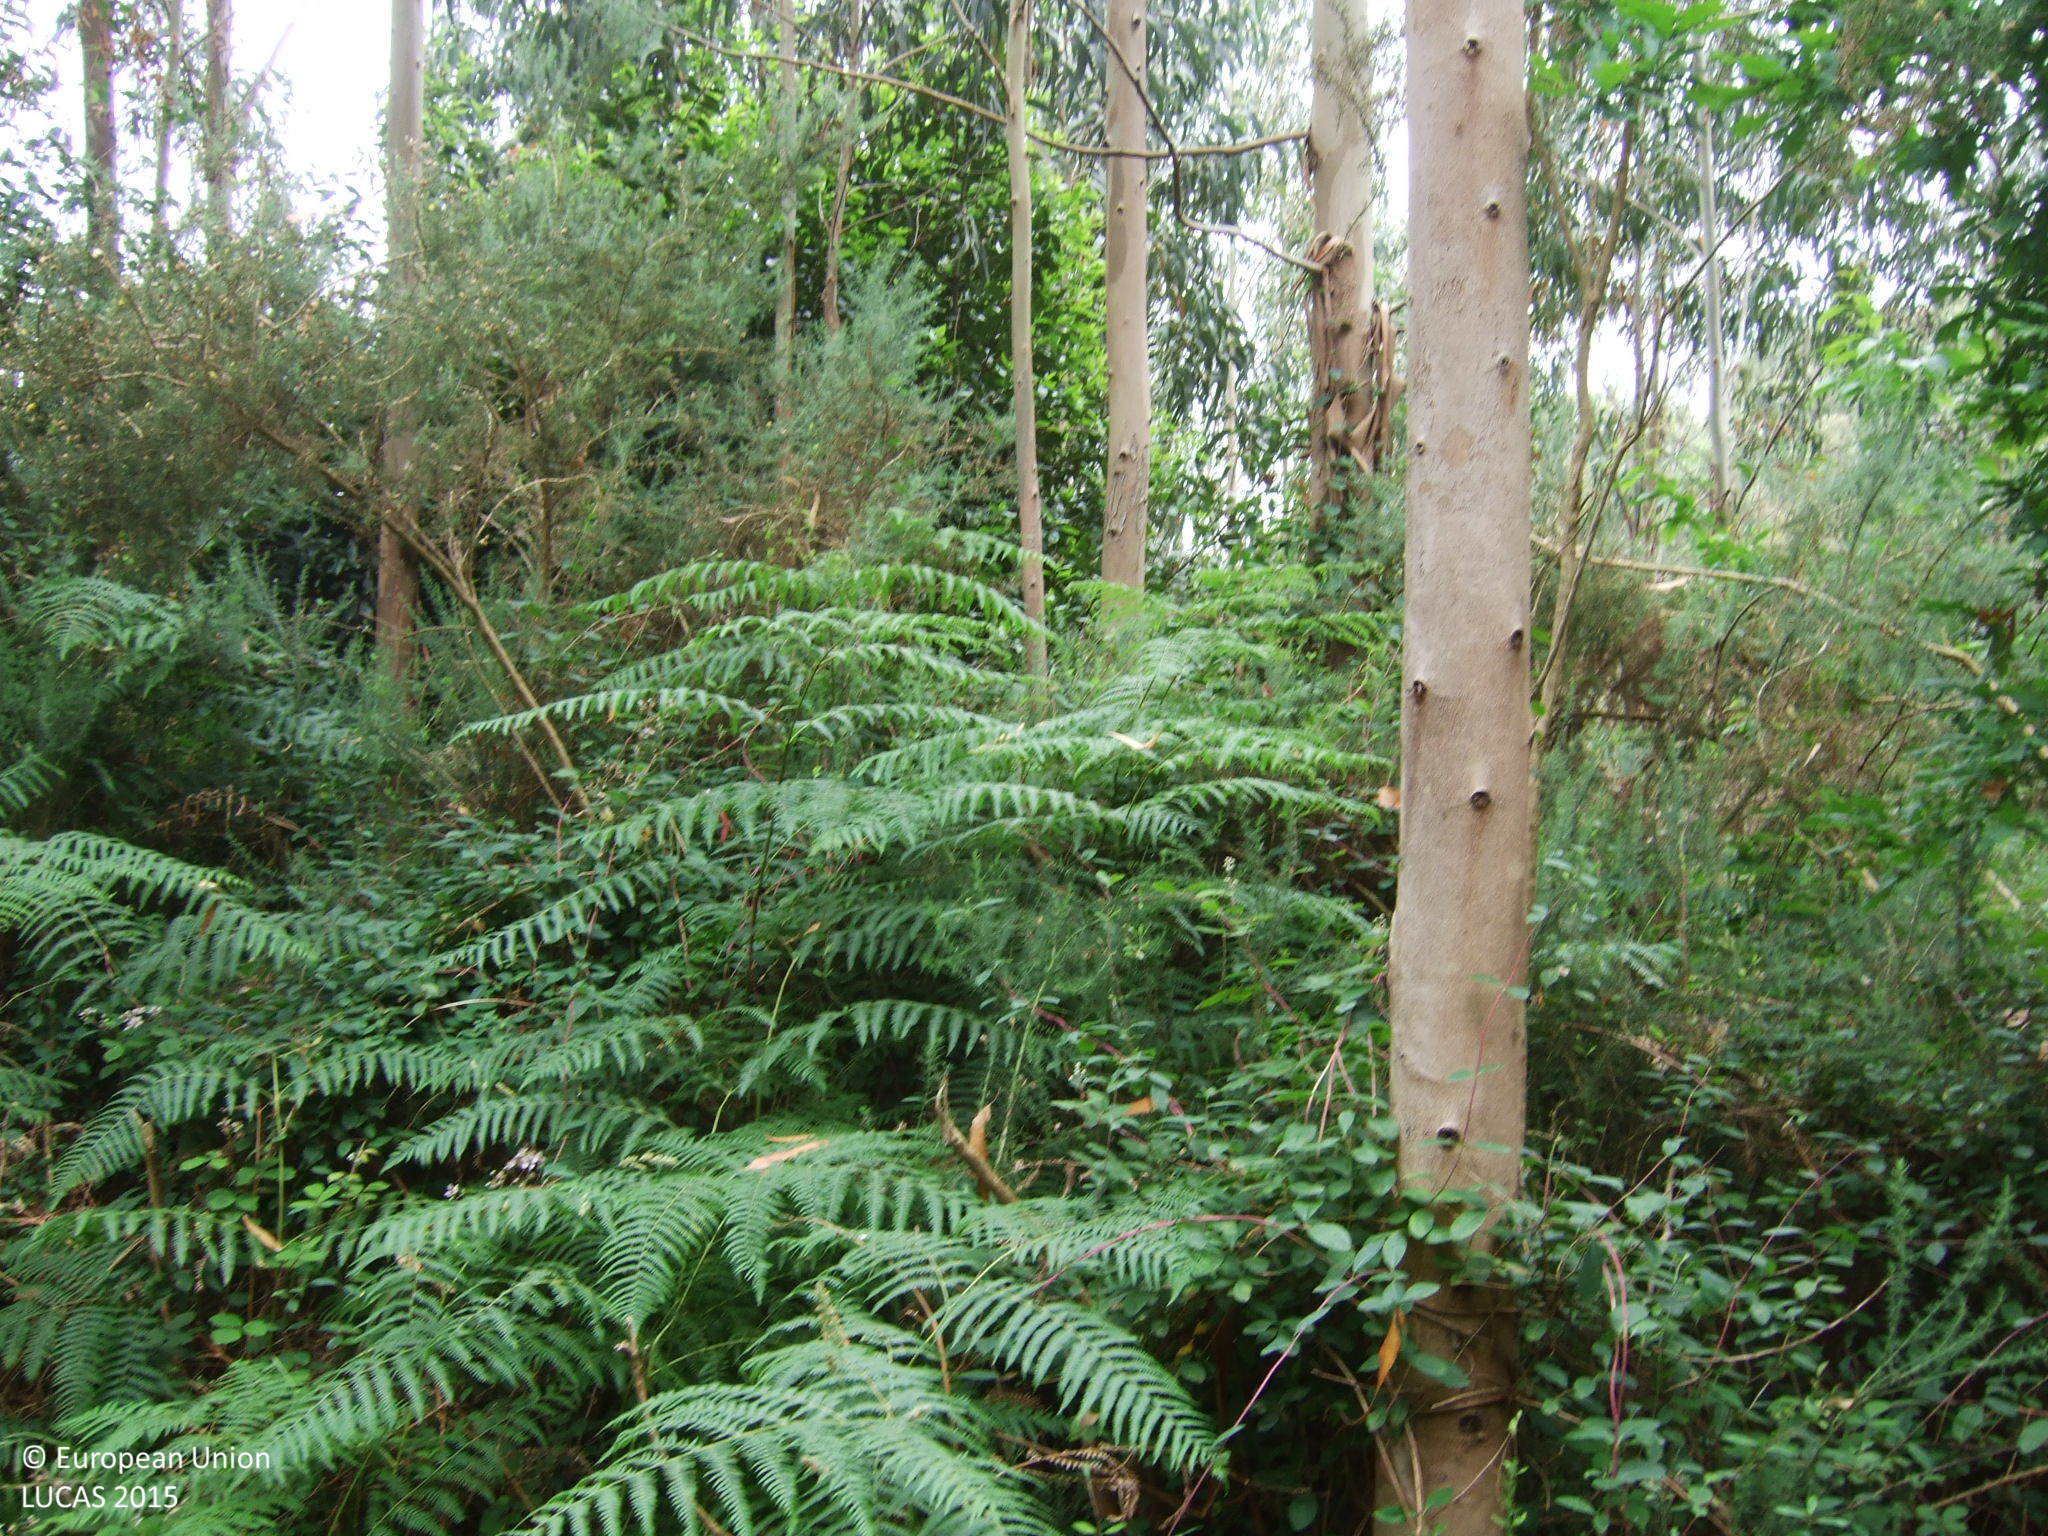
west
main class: Woodland
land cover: Broadleaved woodland
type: exotic forest
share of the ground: 50 - 75 %
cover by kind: broadleaved forest trees 65 %, shrubs 35 %
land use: Forestry
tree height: > 5 m
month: June
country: ES
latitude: 43.6463
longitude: -7.5783
